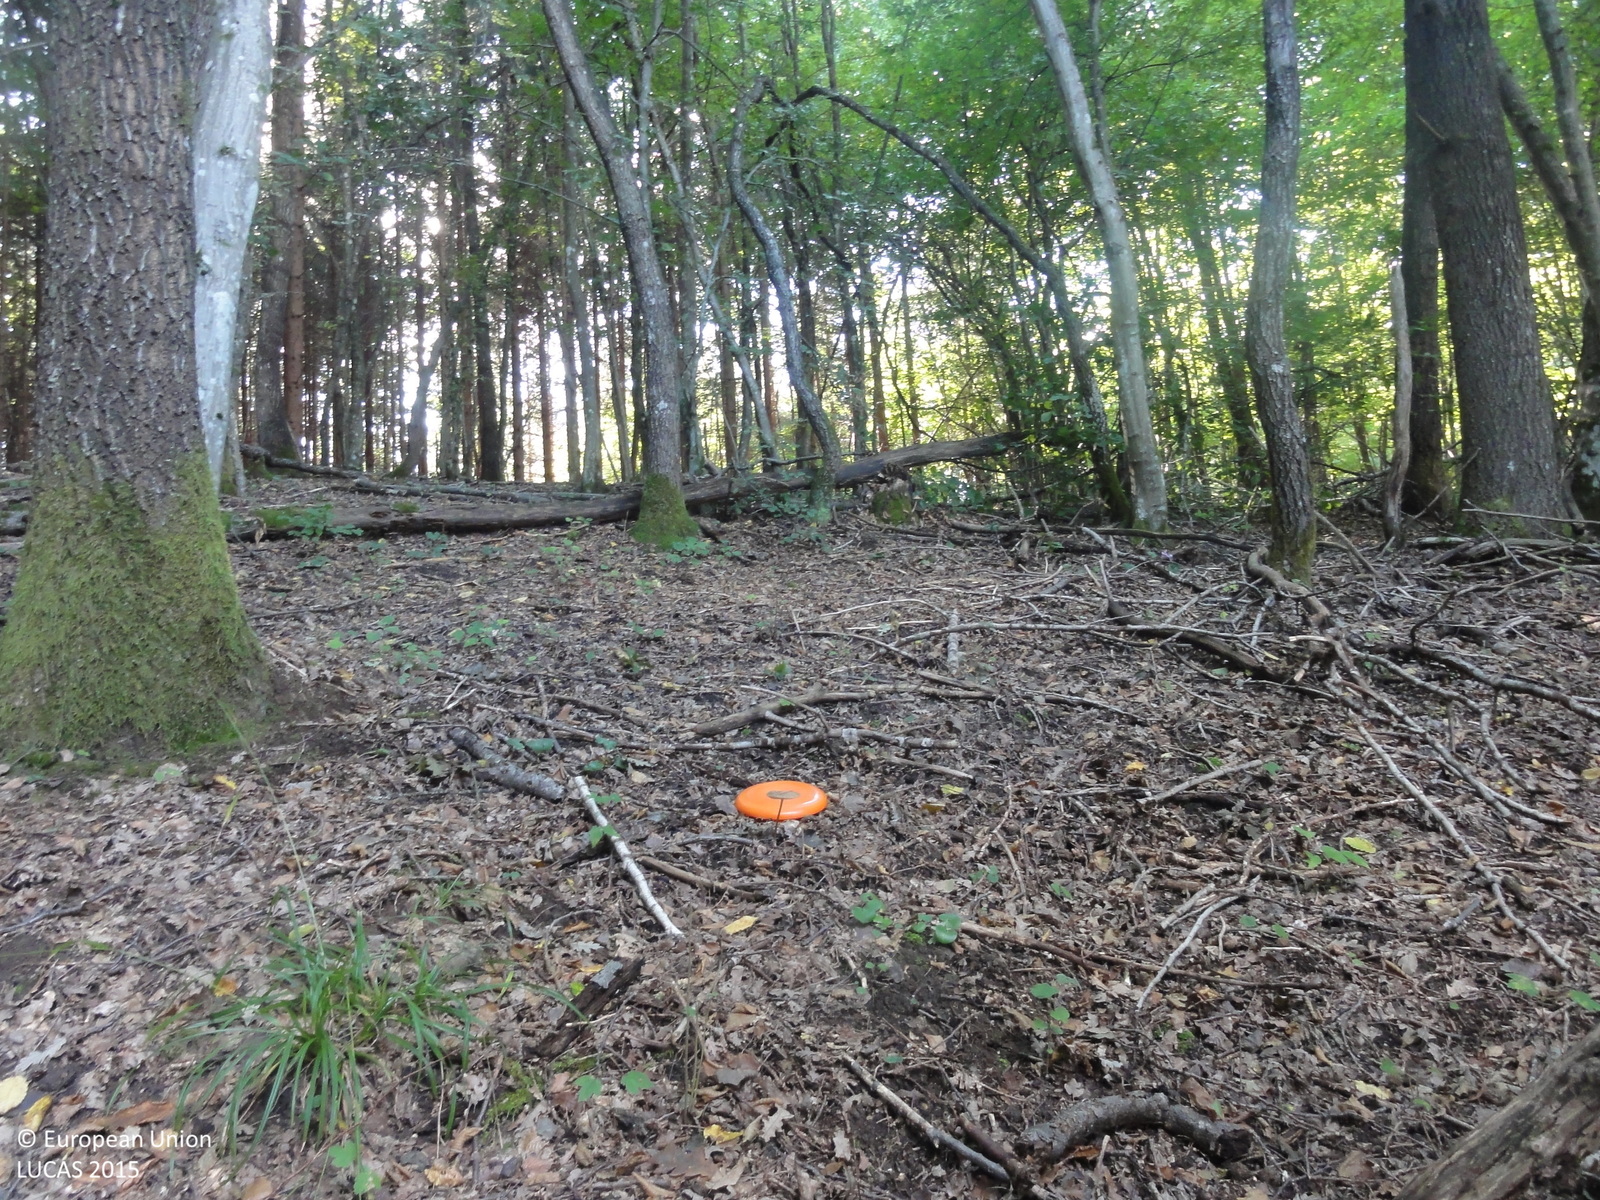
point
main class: Woodland
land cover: Broadleaved woodland
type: mesophytic deciduous forest
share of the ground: > 75 %
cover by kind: broadleaved forest trees 100 %
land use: Forestry
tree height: > 5 m
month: September
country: SI
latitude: 45.7194
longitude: 15.1997
